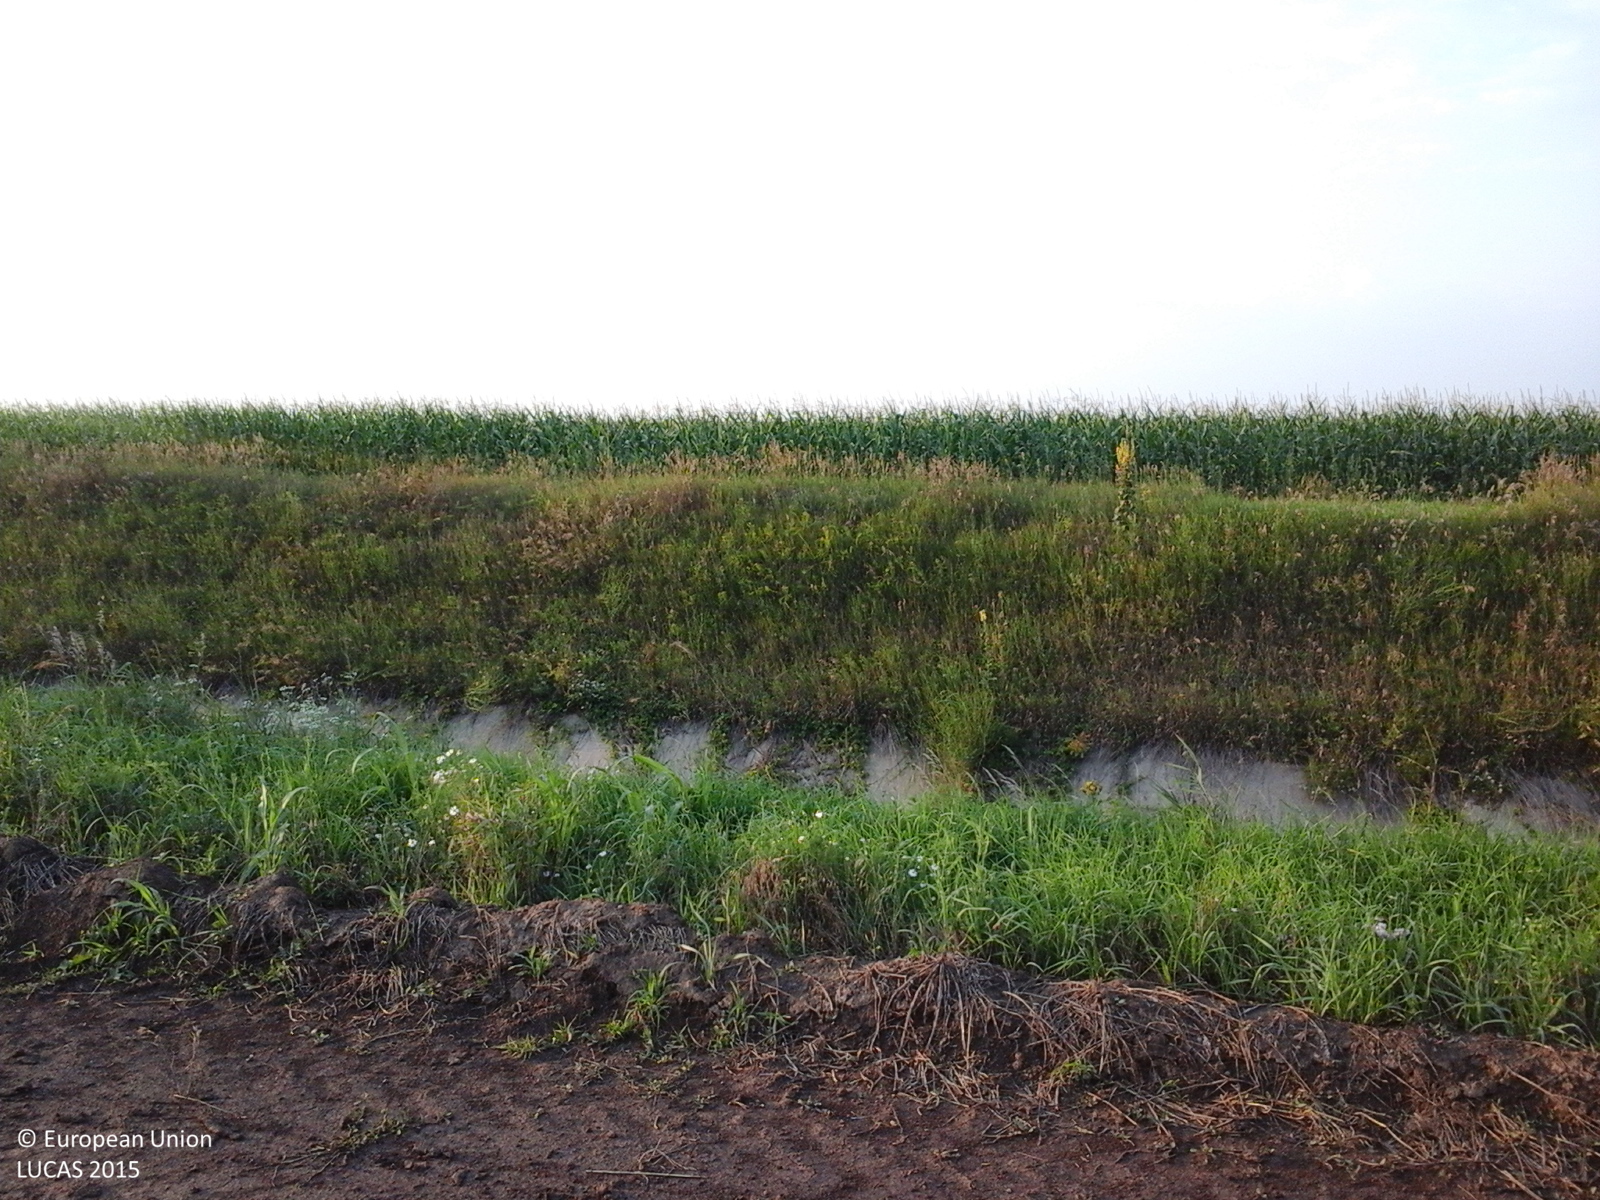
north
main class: Cropland
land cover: Rape and turnip rape
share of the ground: > 75 %
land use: Agriculture (excluding fallow land and kitchen gardens)
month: July
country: RO
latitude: 43.7726
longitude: 25.3243
